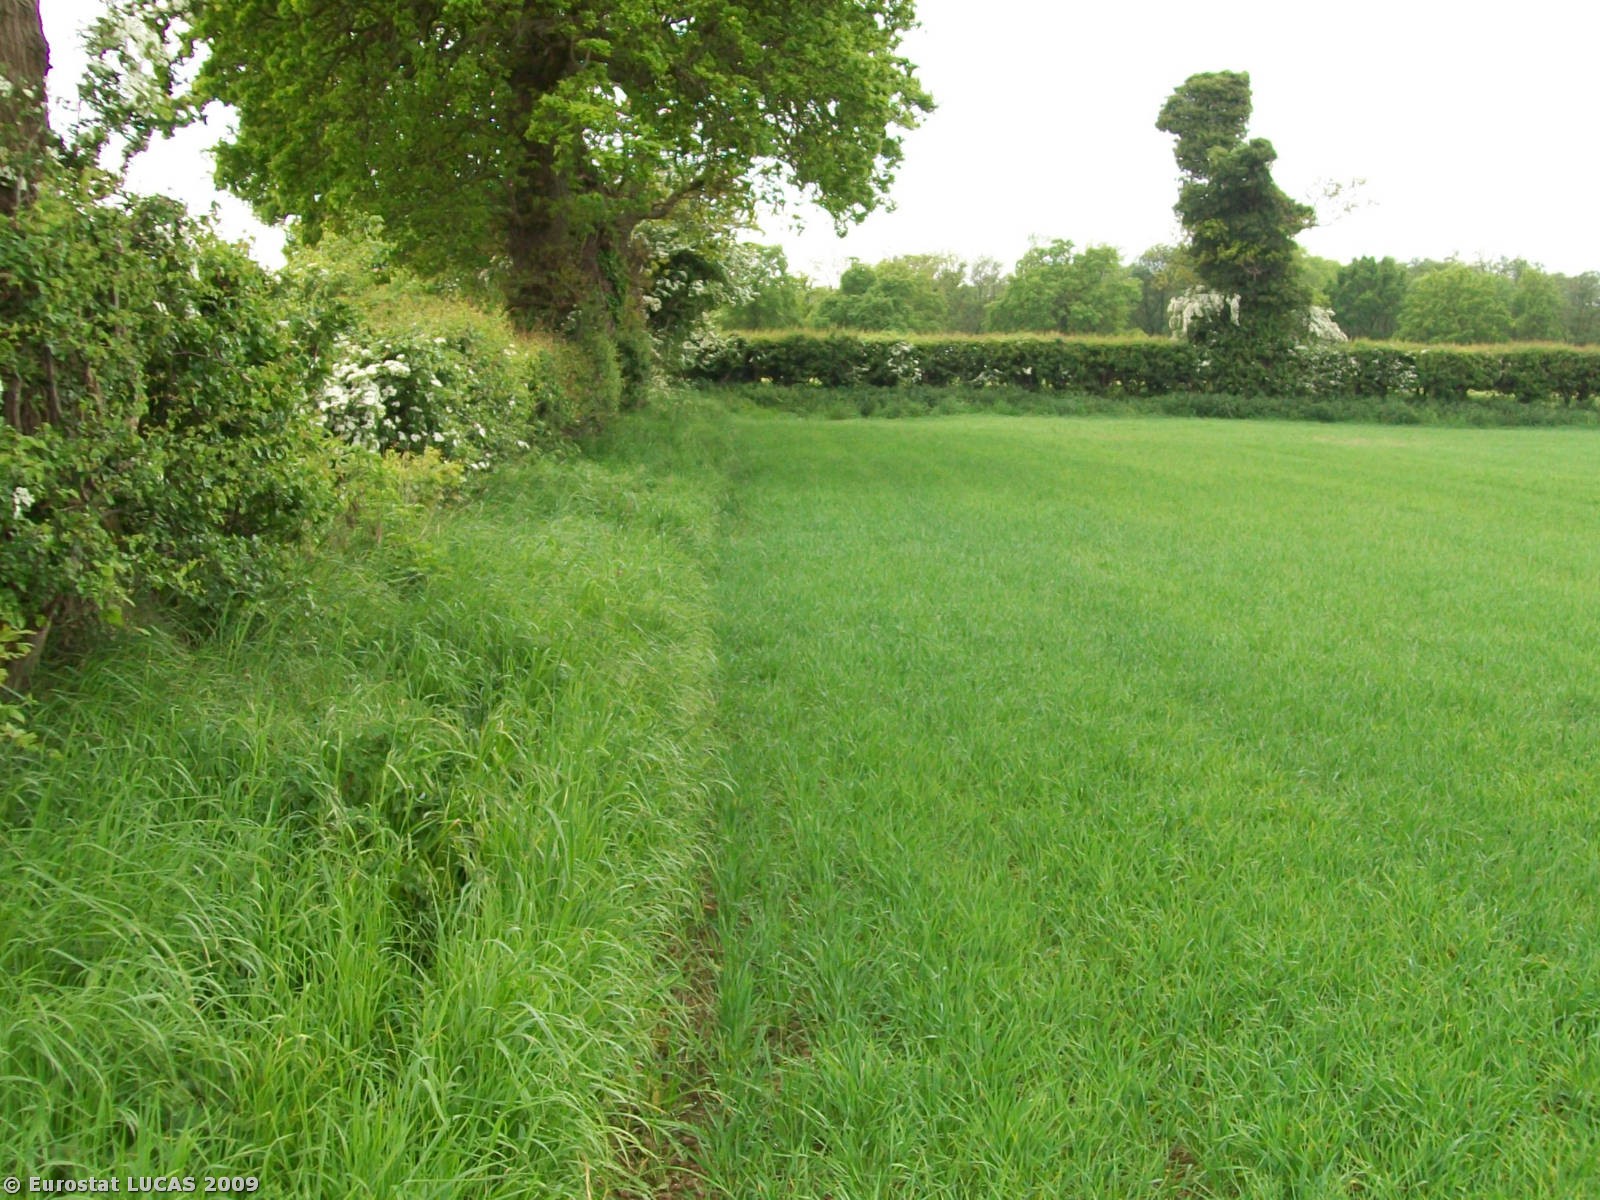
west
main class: Cropland
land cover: Common wheat
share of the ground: > 75 %
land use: Agriculture (excluding fallow land and kitchen gardens)
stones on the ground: < 10 %
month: May
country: GB
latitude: 52.7250
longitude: 1.5267
